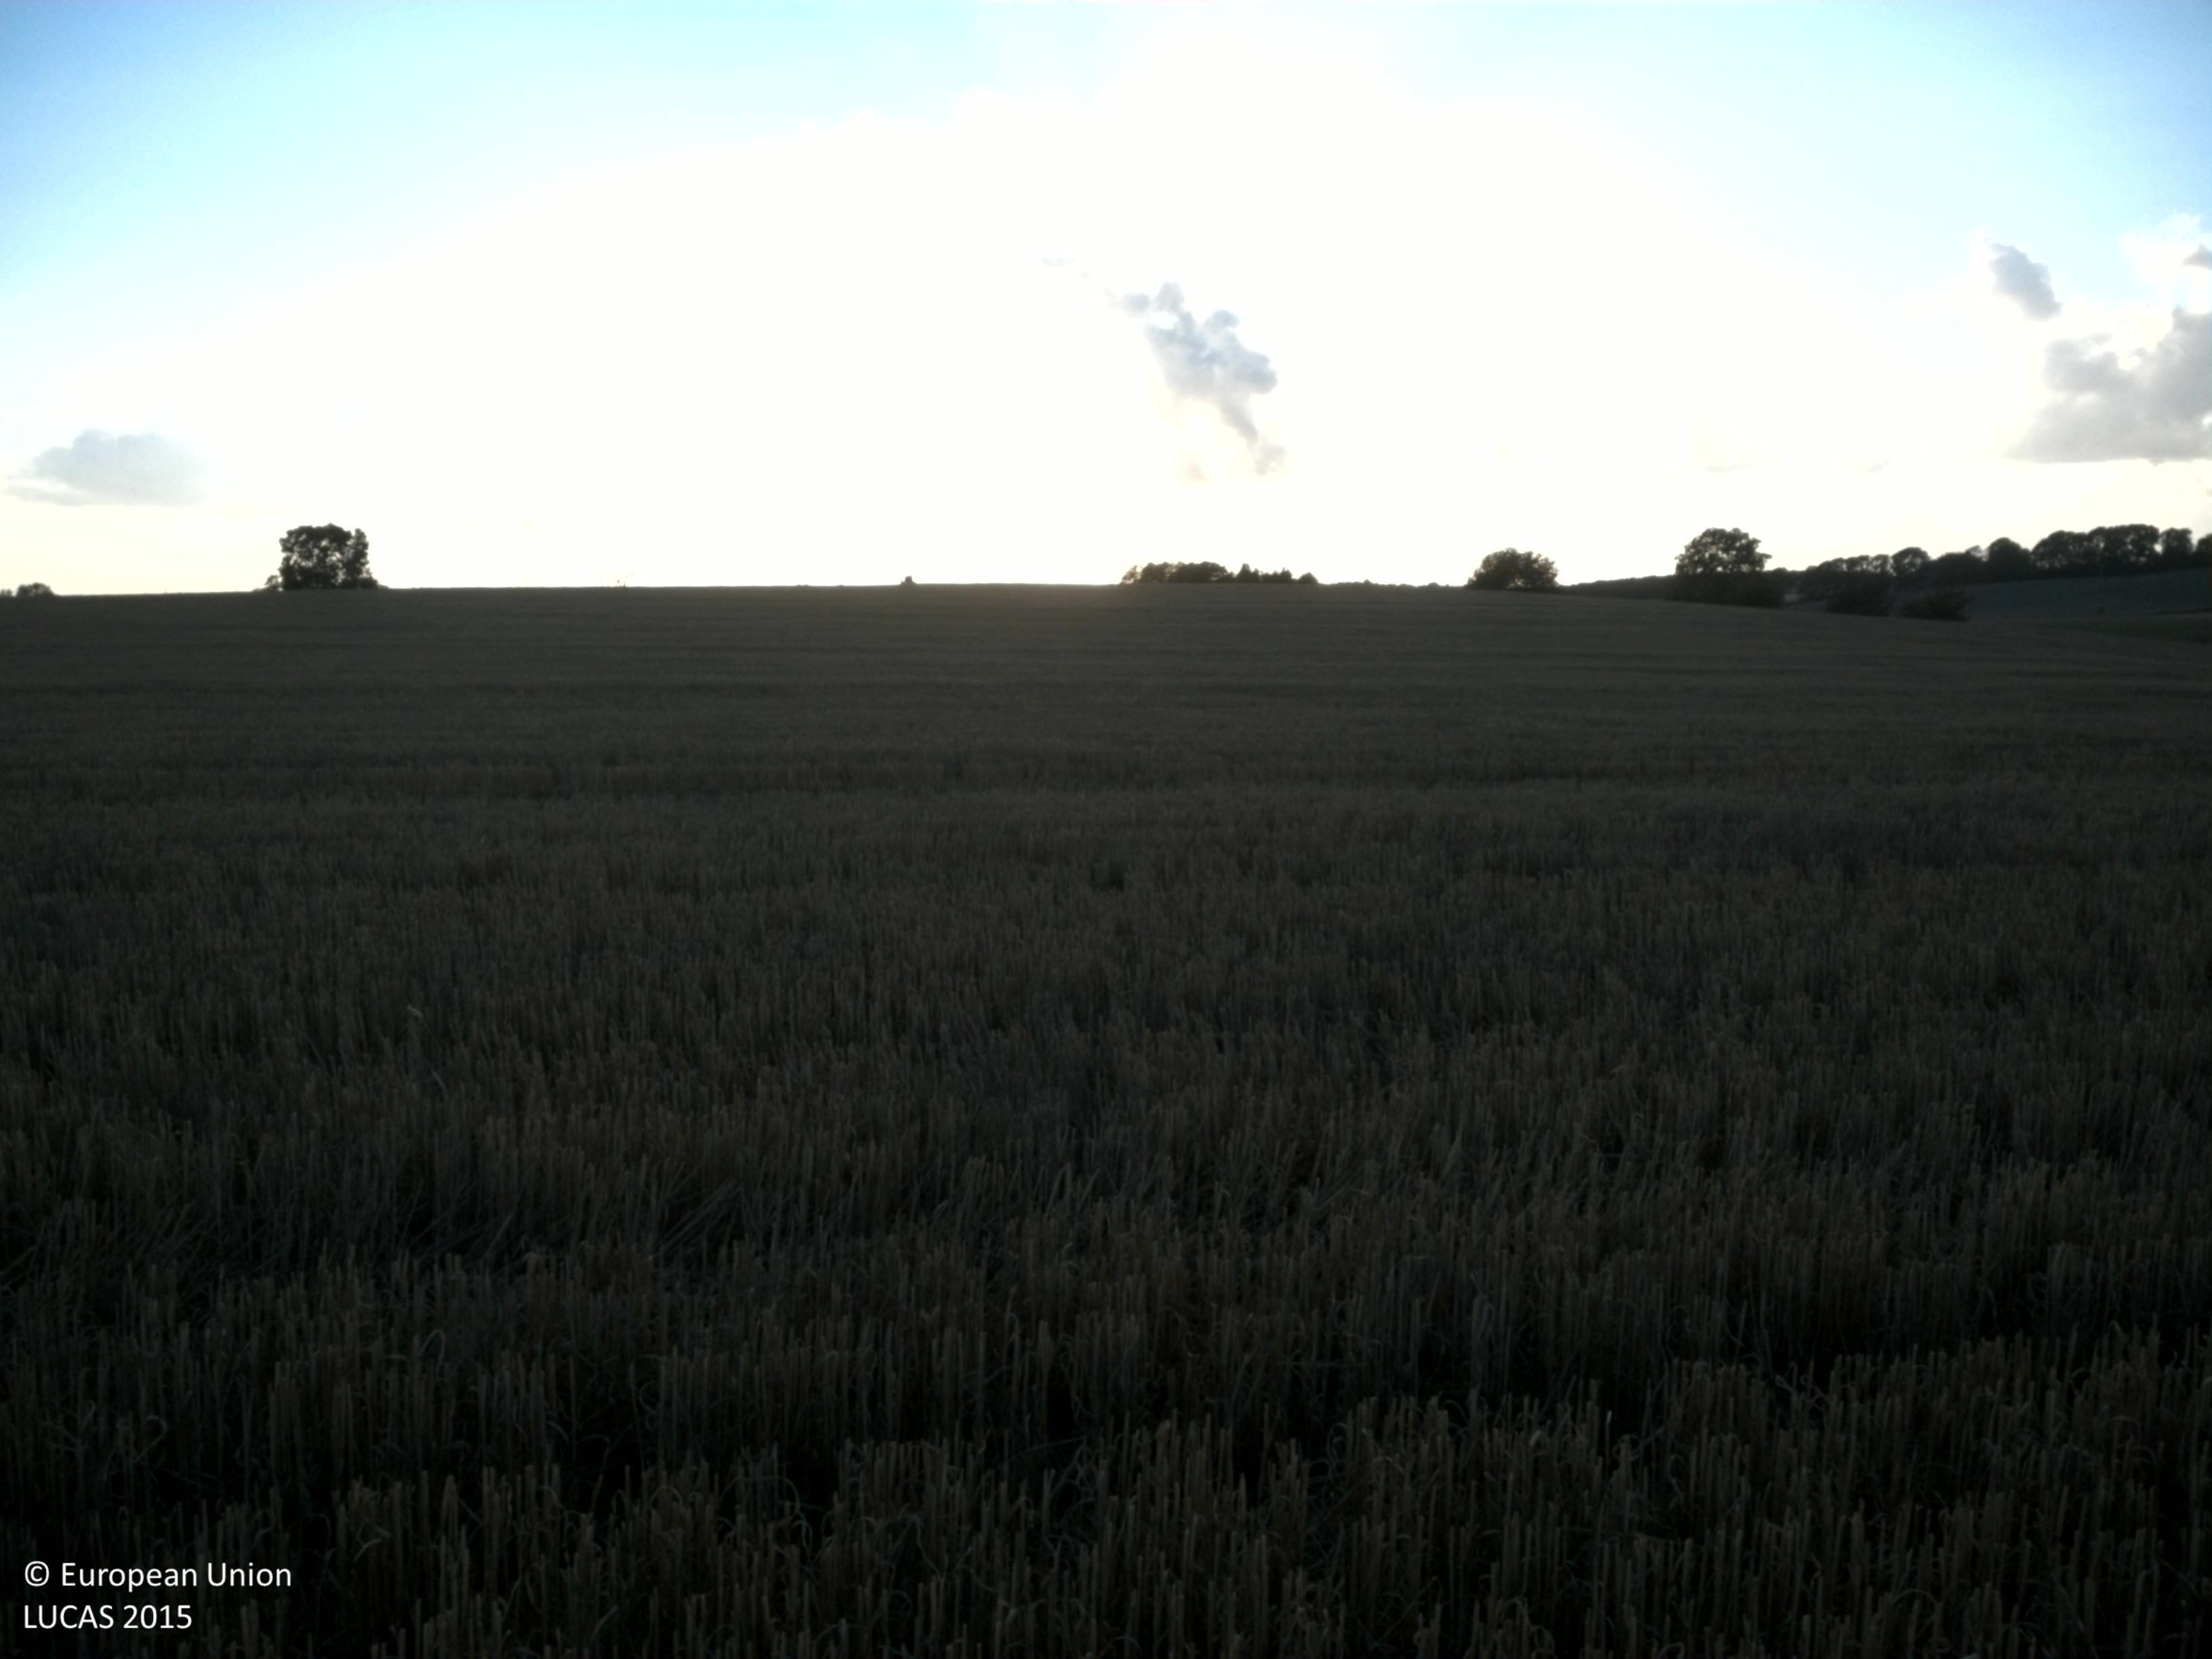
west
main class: Cropland
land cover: Common wheat
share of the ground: 25 - 50 %
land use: Agriculture (excluding fallow land and kitchen gardens)
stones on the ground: < 10 %
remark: Harvested field
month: September
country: SE
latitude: 55.4765
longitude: 14.0330
